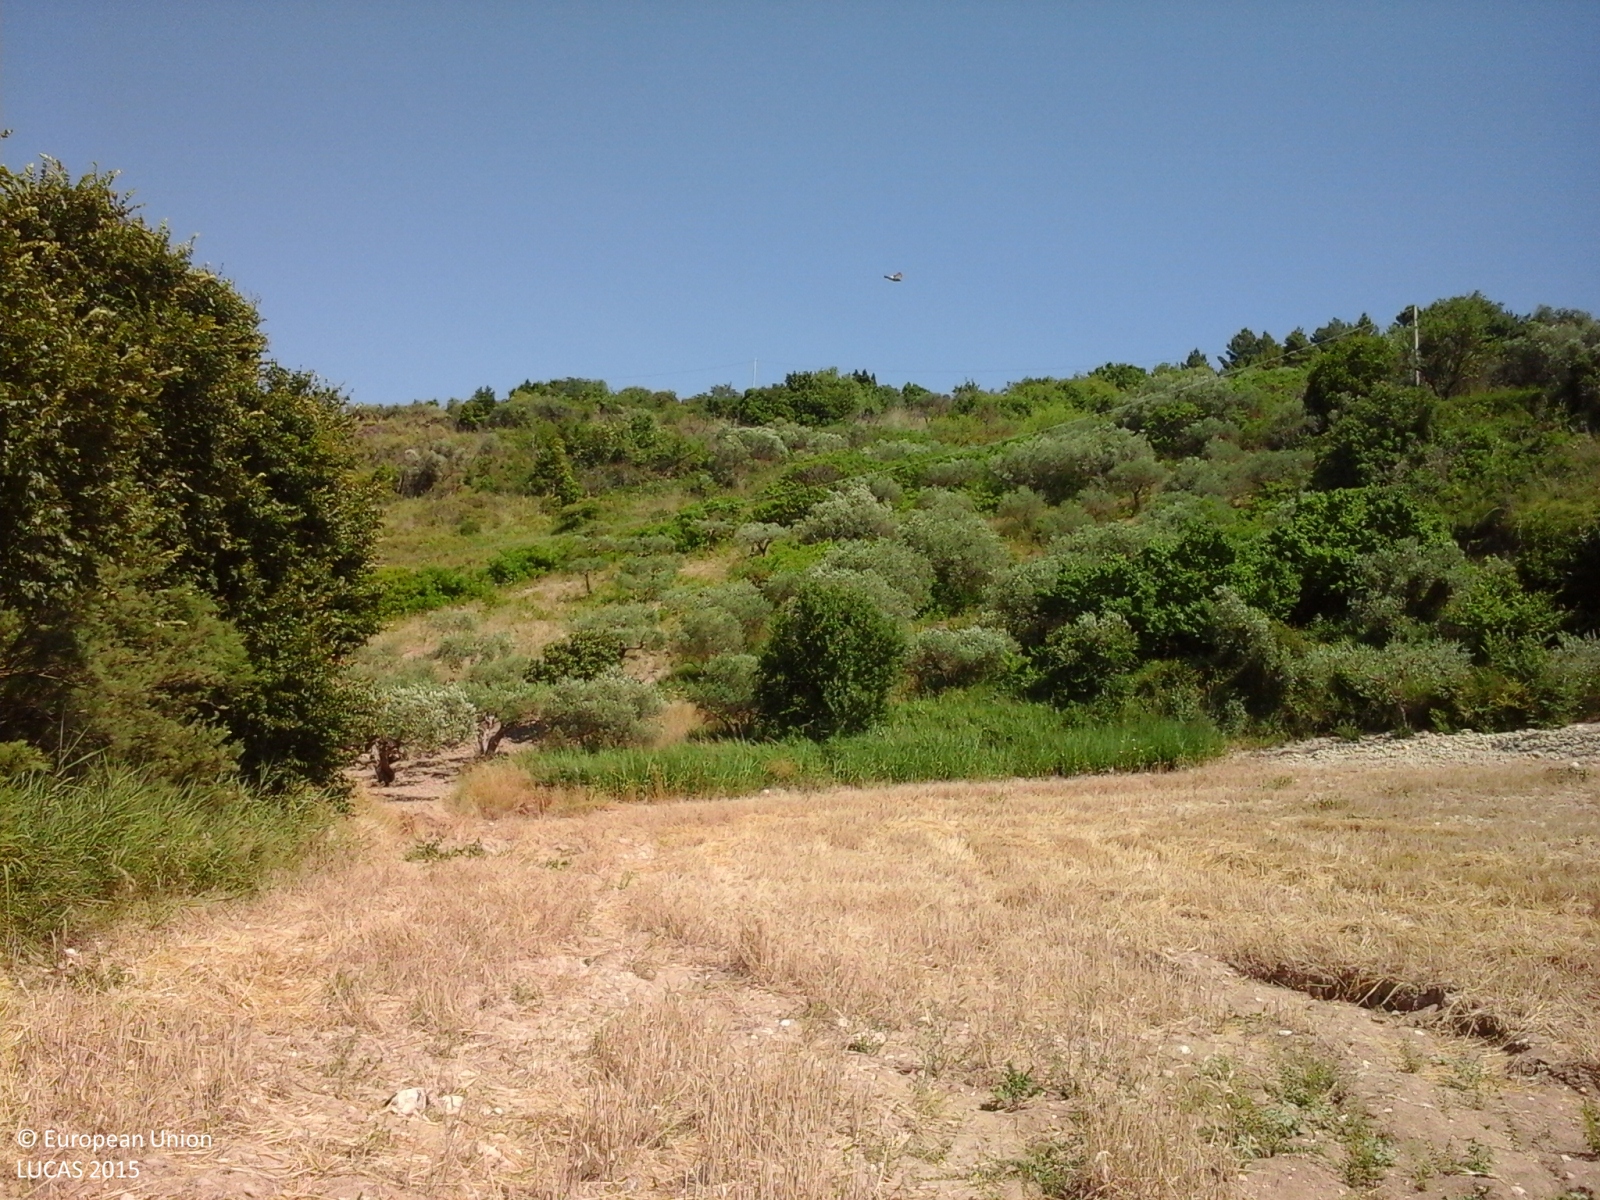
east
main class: Woodland
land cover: Other mixed woodland
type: coniferous forest of the mediterranean region
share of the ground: > 75 %
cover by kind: coniferous forest trees 35 %, broadleaved forest trees 35 %, shrubs 20 %, herbaceous plants 10 %
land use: Forestry
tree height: > 5 m
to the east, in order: Other mixed woodland; Rivers and streams; Olive groves; Shrubland without tree cover; Olive groves
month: June
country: IT
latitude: 37.6420
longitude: 13.1158
